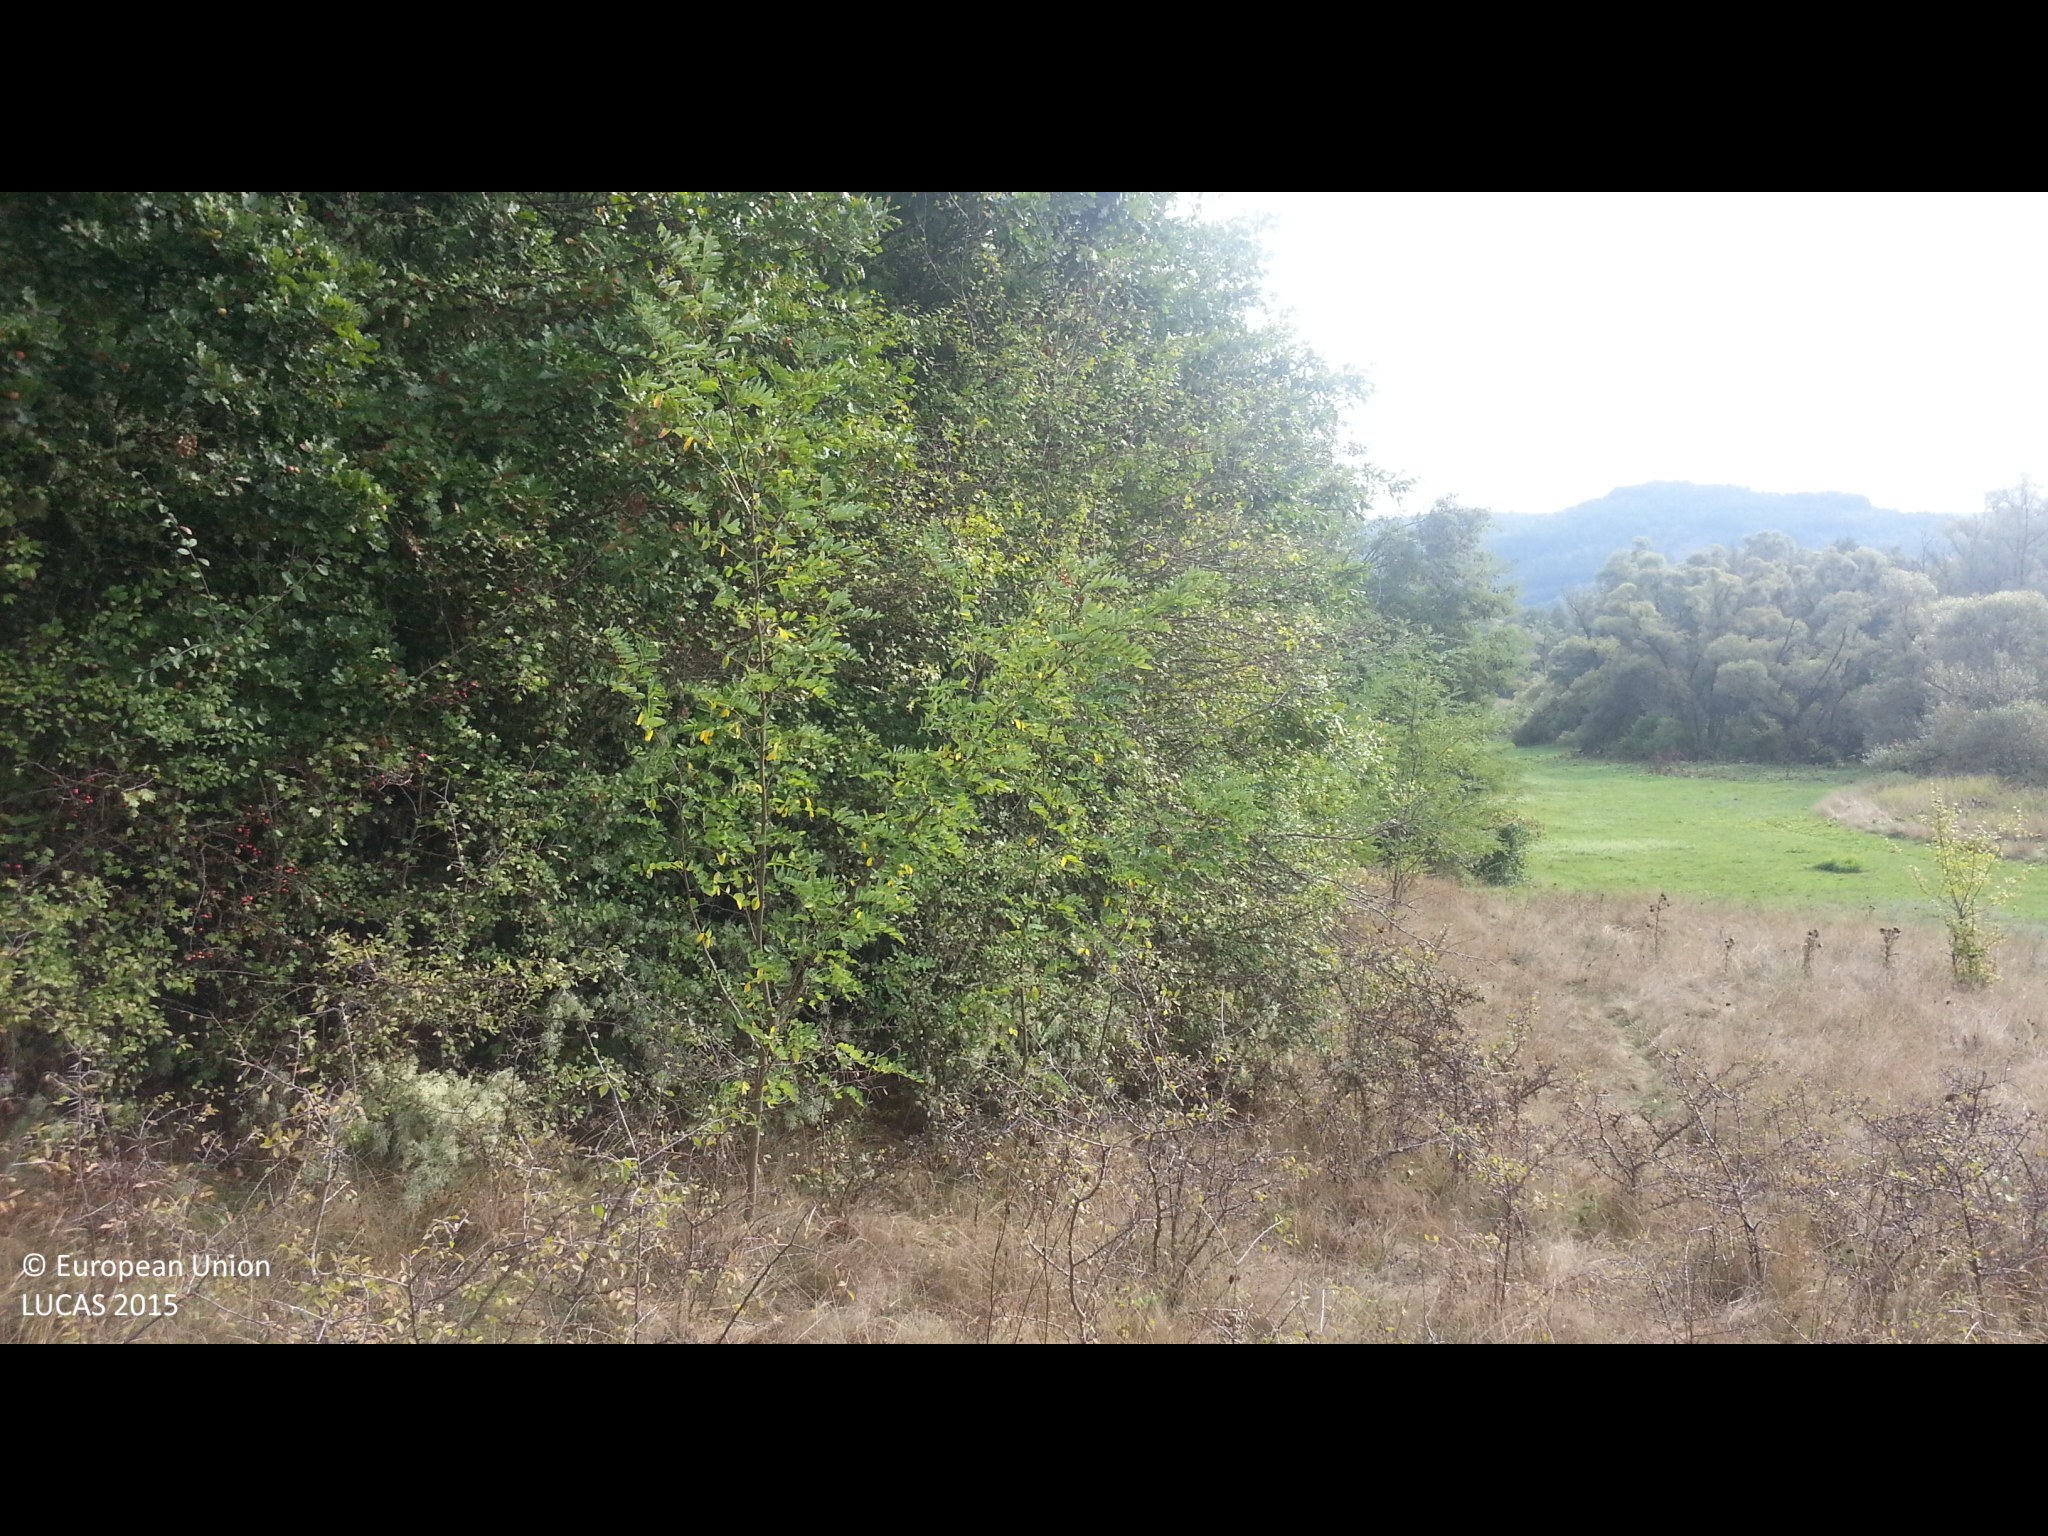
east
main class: Woodland
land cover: Other coniferous woodland
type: hemiboreal forest and nemoral coniferous forest and mixed broadleaved-coniferous forest
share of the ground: > 75 %
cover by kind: coniferous forest trees 100 %
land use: Forestry
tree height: > 5 m
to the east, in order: Other coniferous woodland; Ditches and canals; Other coniferous woodland; Ditches and canals; Other mixed woodland
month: September
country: BG
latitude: 42.5598
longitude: 22.5807
